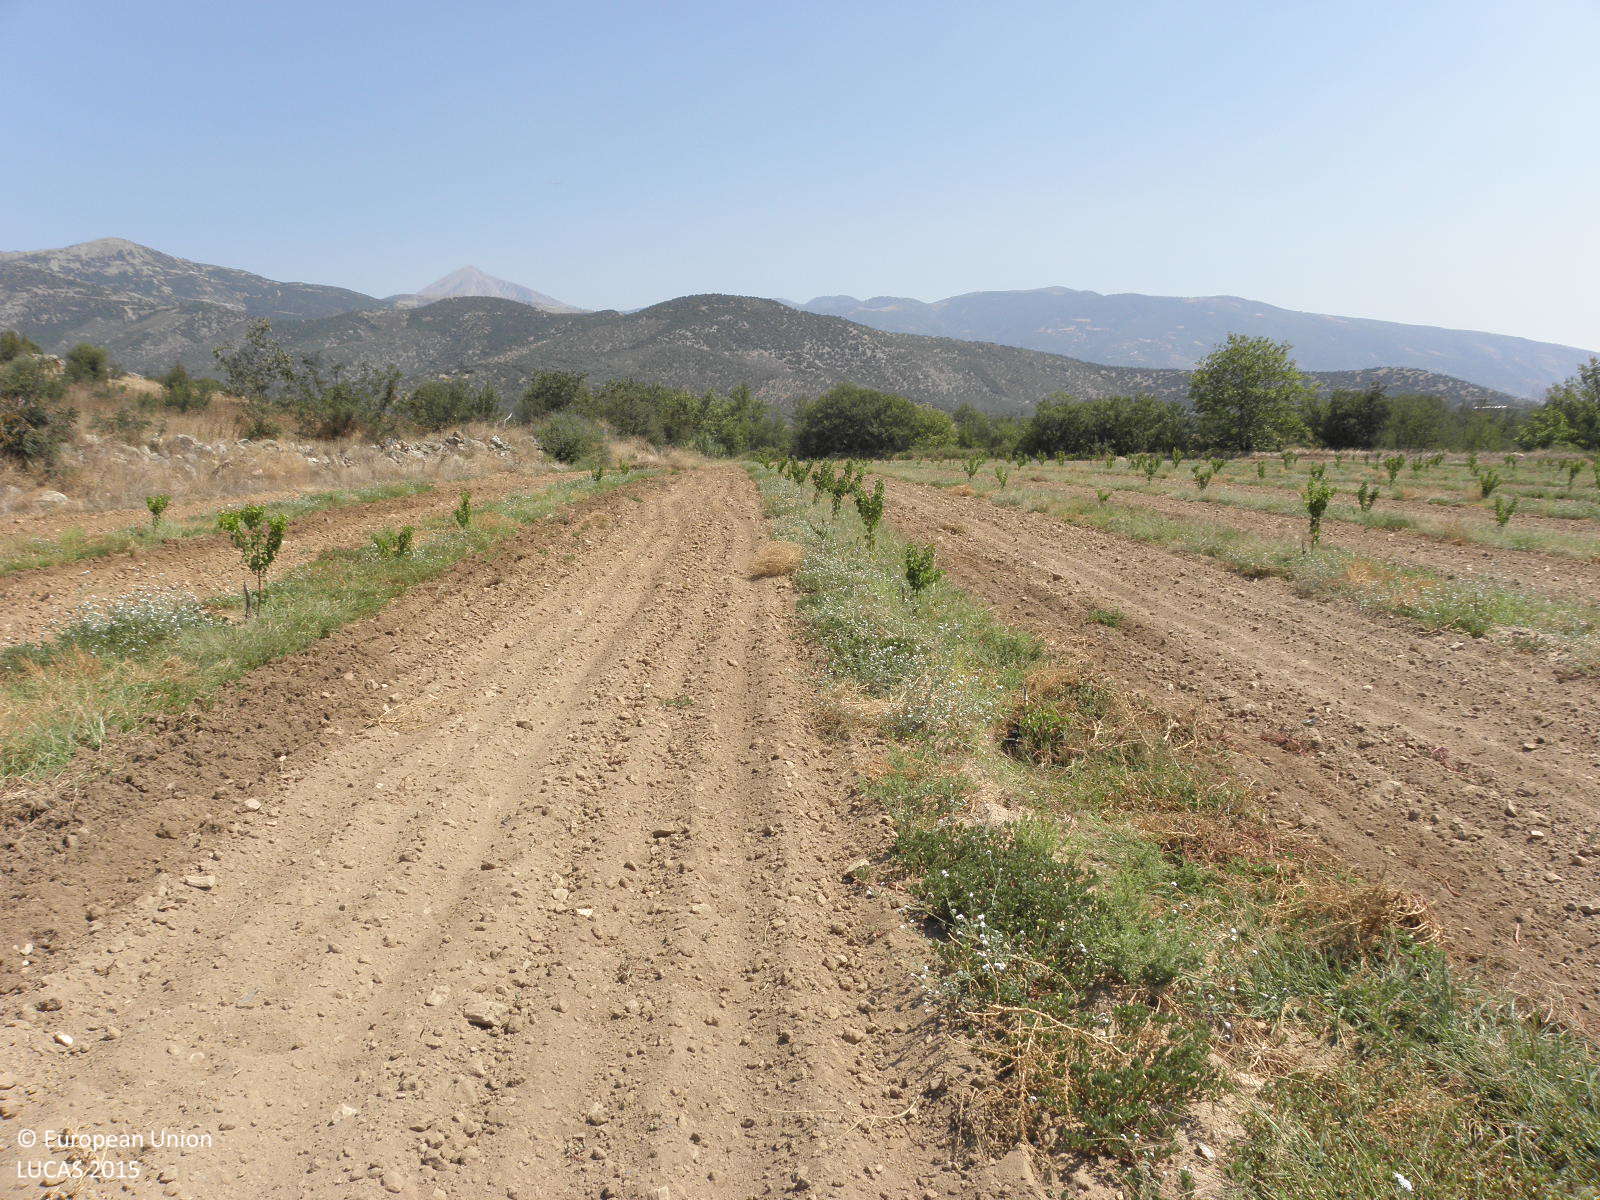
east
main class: Cropland
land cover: Other fruit trees and berries
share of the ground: < 10 %
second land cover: Spontaneously vegetated surfaces
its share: 25 - 50 %
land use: Agriculture (excluding fallow land and kitchen gardens)
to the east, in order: Other fruit trees and berries; Spontaneously vegetated surfaces; Grass margins; Shrubland without tree cover; Tracks; Shrubland with sparse tree cover; Tracks; Grassland with sparse tree/shrub cover; Rivers and streams; Dry stone walls; Grassland with sparse tree/shrub cover; Maize
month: August
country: GR
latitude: 39.7907
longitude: 22.5228
